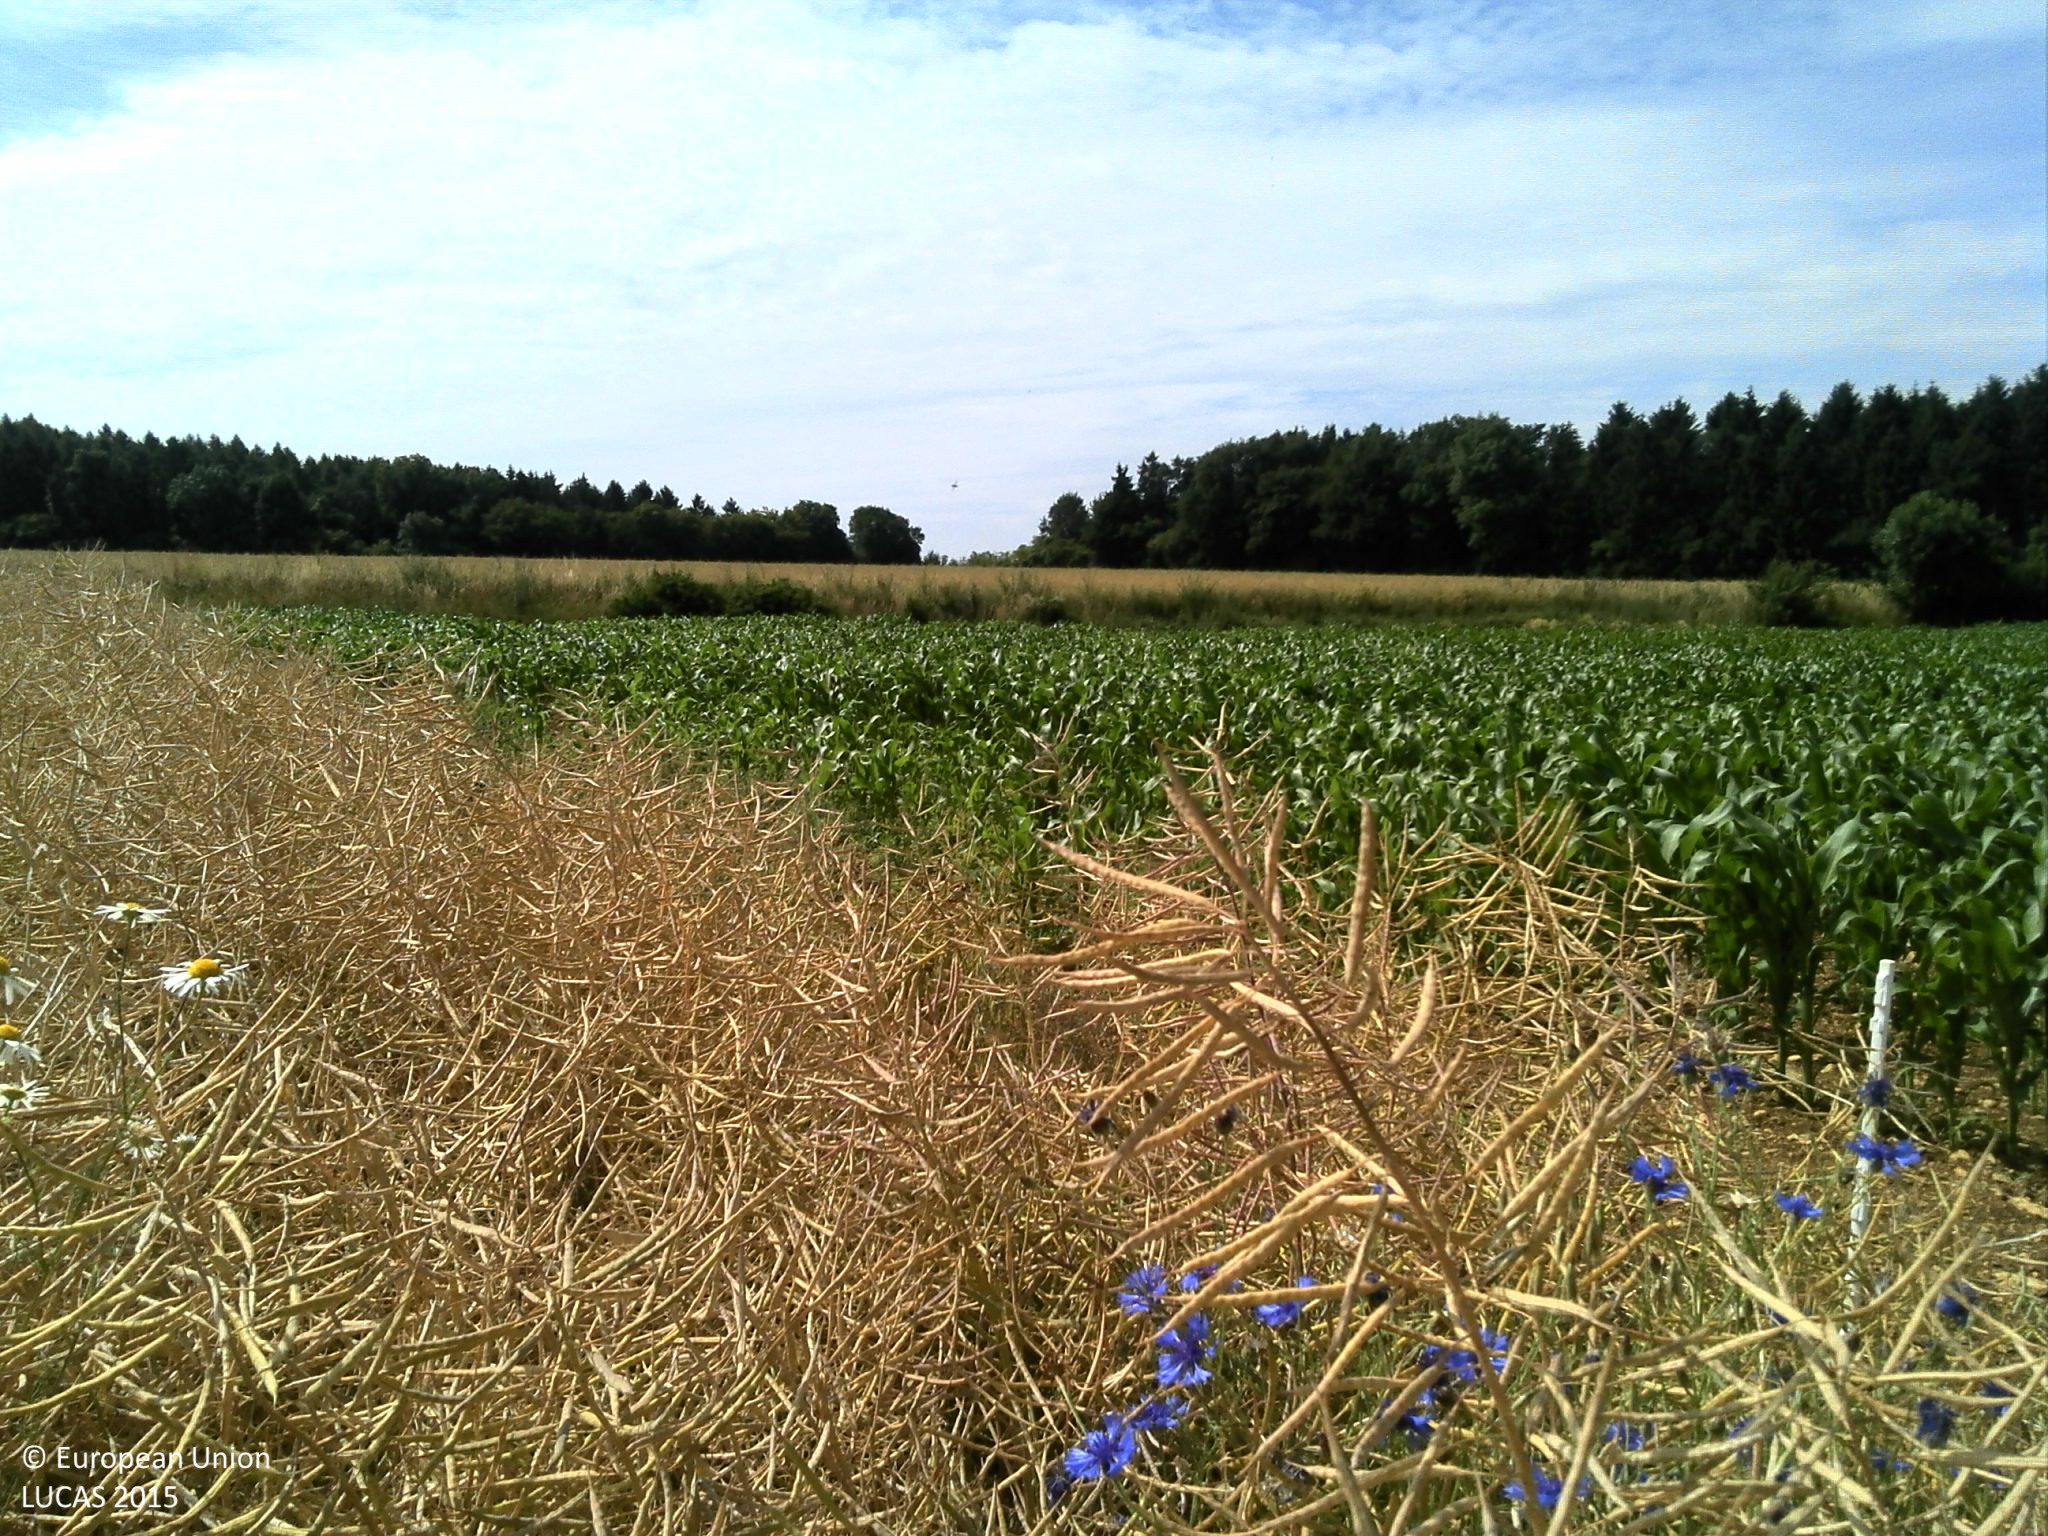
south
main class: Cropland
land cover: Rape and turnip rape
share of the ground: > 75 %
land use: Agriculture (excluding fallow land and kitchen gardens)
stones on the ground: > 50 %
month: June
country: FR
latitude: 49.2149
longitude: 6.0320
